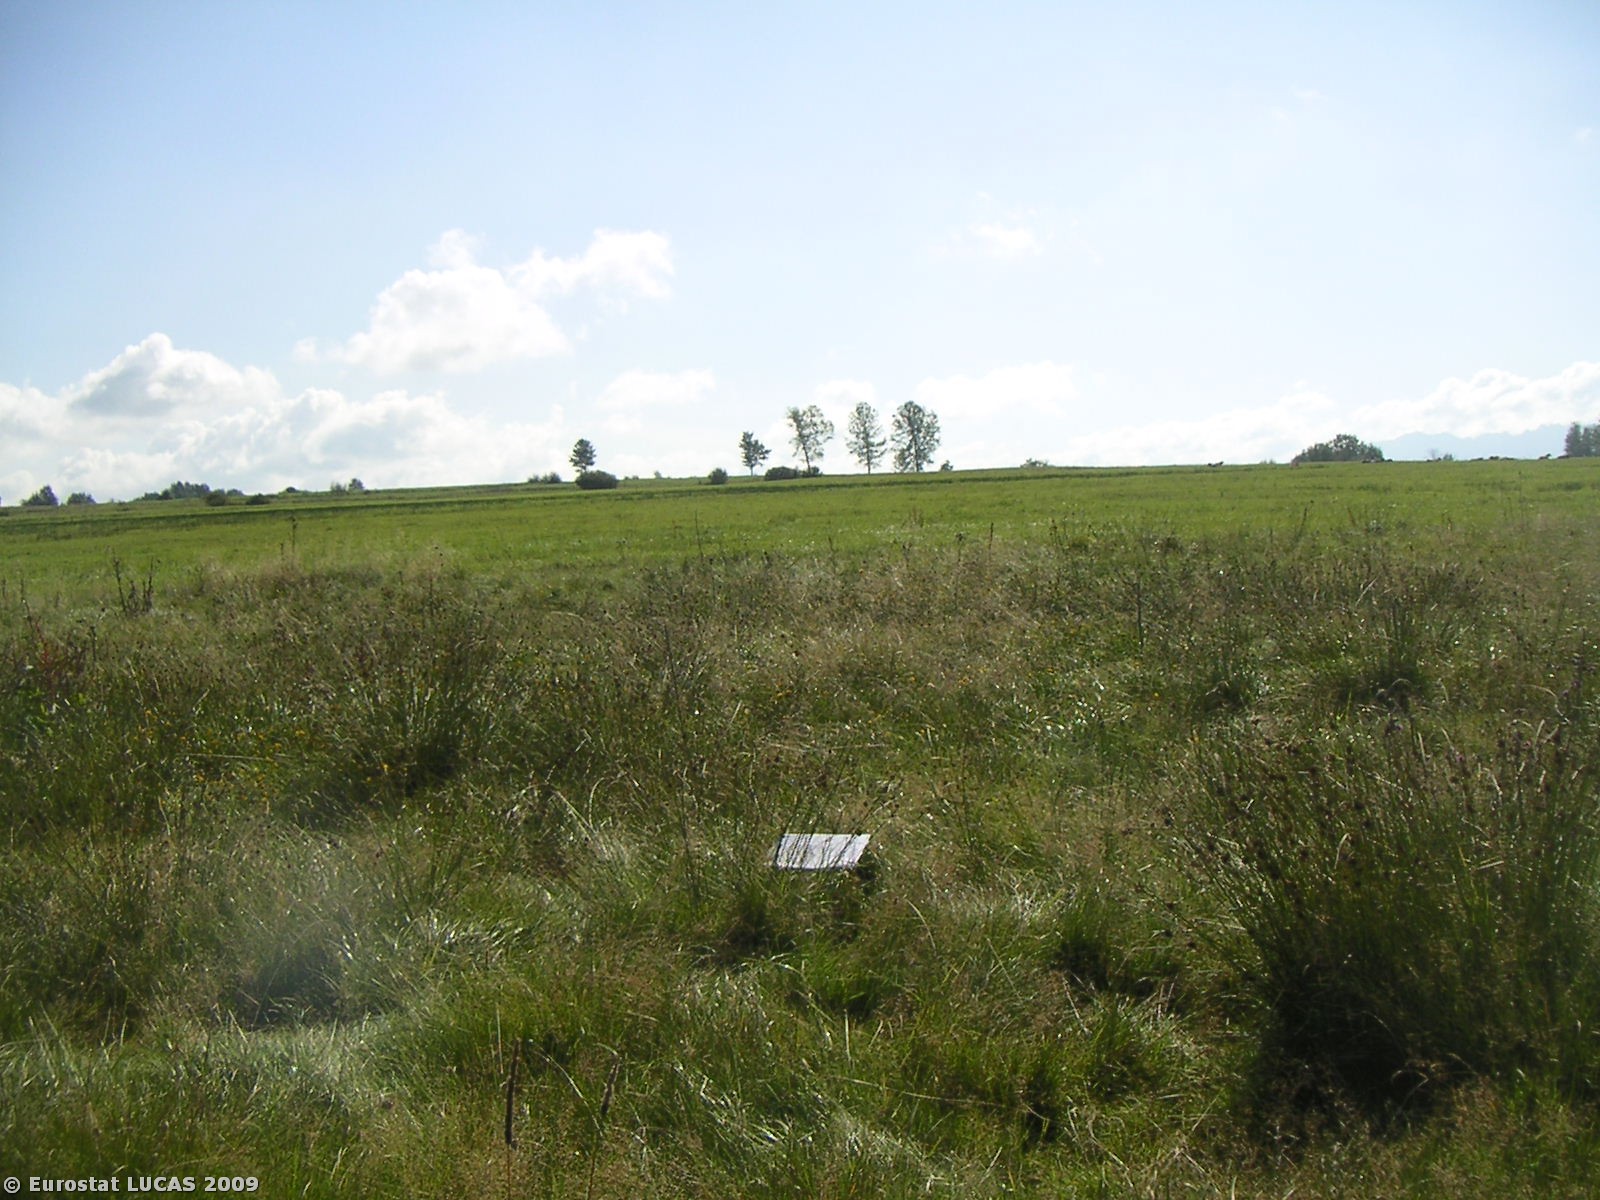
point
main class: Grassland
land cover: Spontaneously vegetated surfaces
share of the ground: > 75 %
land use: Fallow land
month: September
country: PL
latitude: 49.4118
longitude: 19.8574
